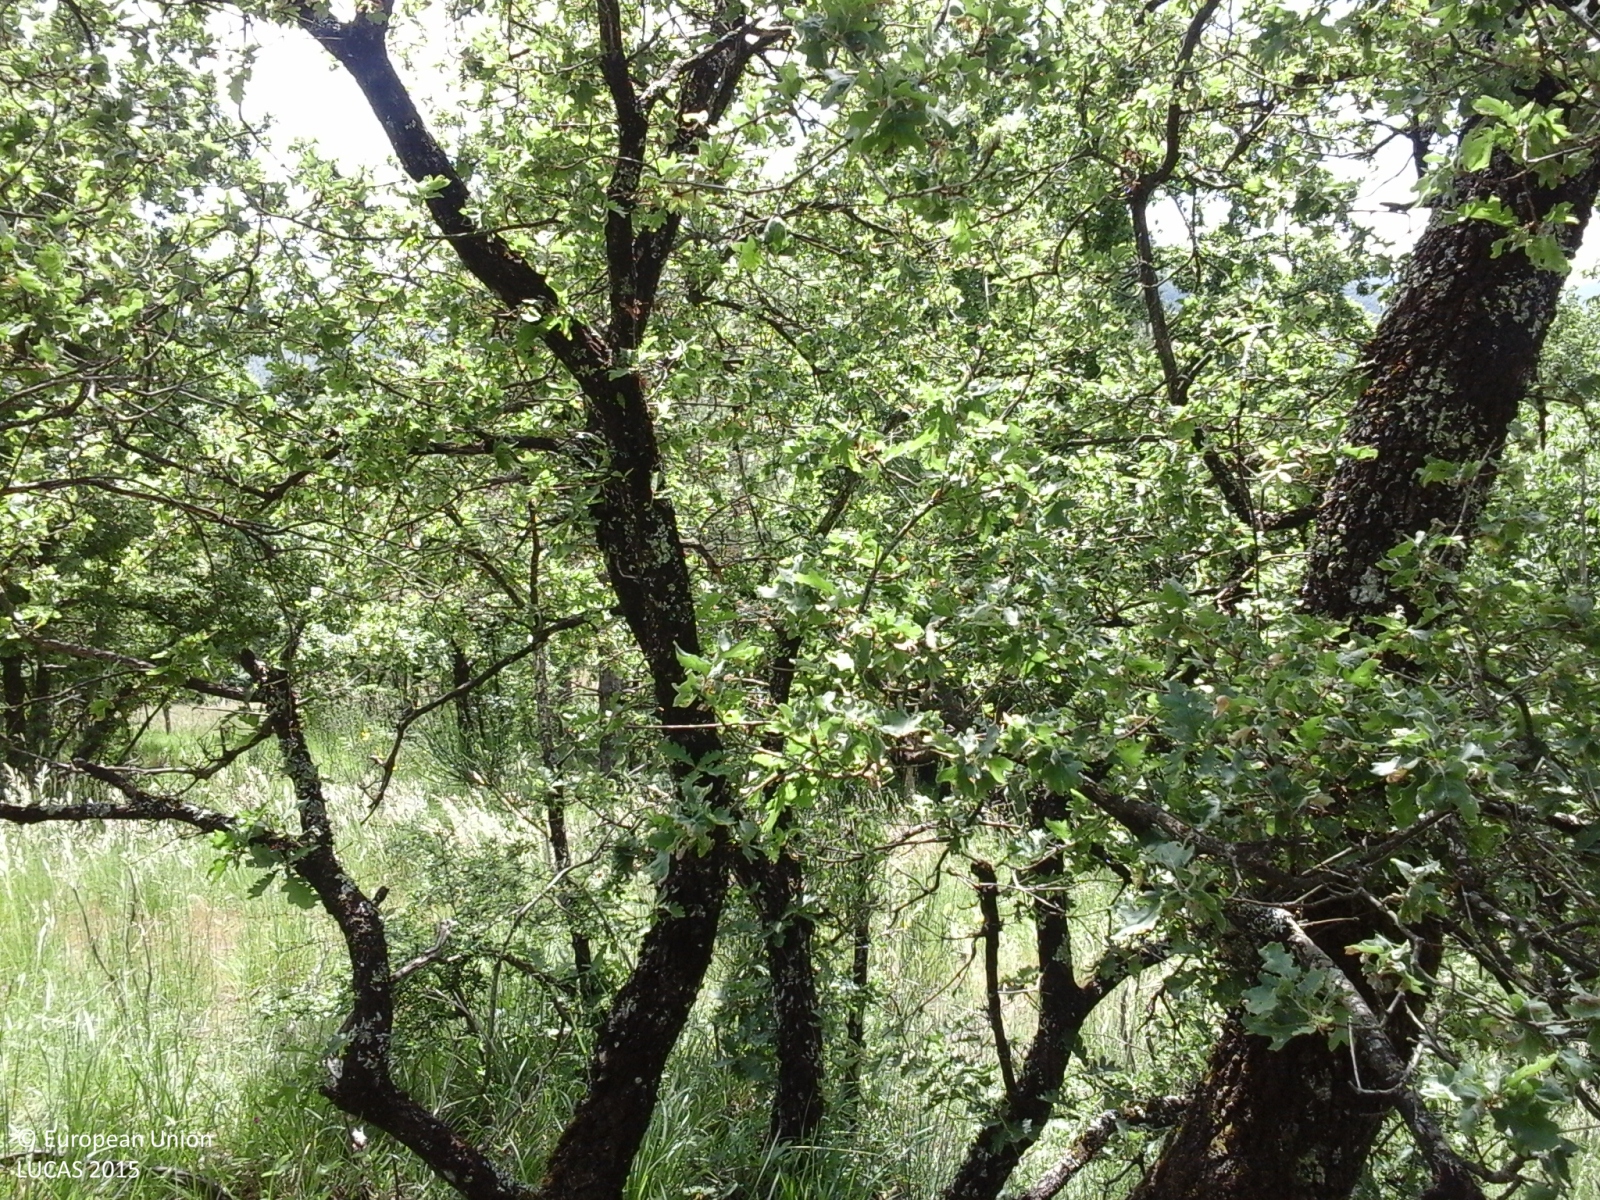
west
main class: Woodland
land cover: Broadleaved woodland
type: thermophilous deciduous forest
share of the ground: > 75 %
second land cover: Grassland without tree/shrub cover
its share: > 75 %
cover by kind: broadleaved forest trees 70 %, herbaceous plants 20 %, shrubs 10 %
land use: Forestry
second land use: Agriculture (excluding fallow land and kitchen gardens)
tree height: > 5 m
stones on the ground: 10 - 25 %
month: May
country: IT
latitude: 44.0380
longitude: 11.1079
